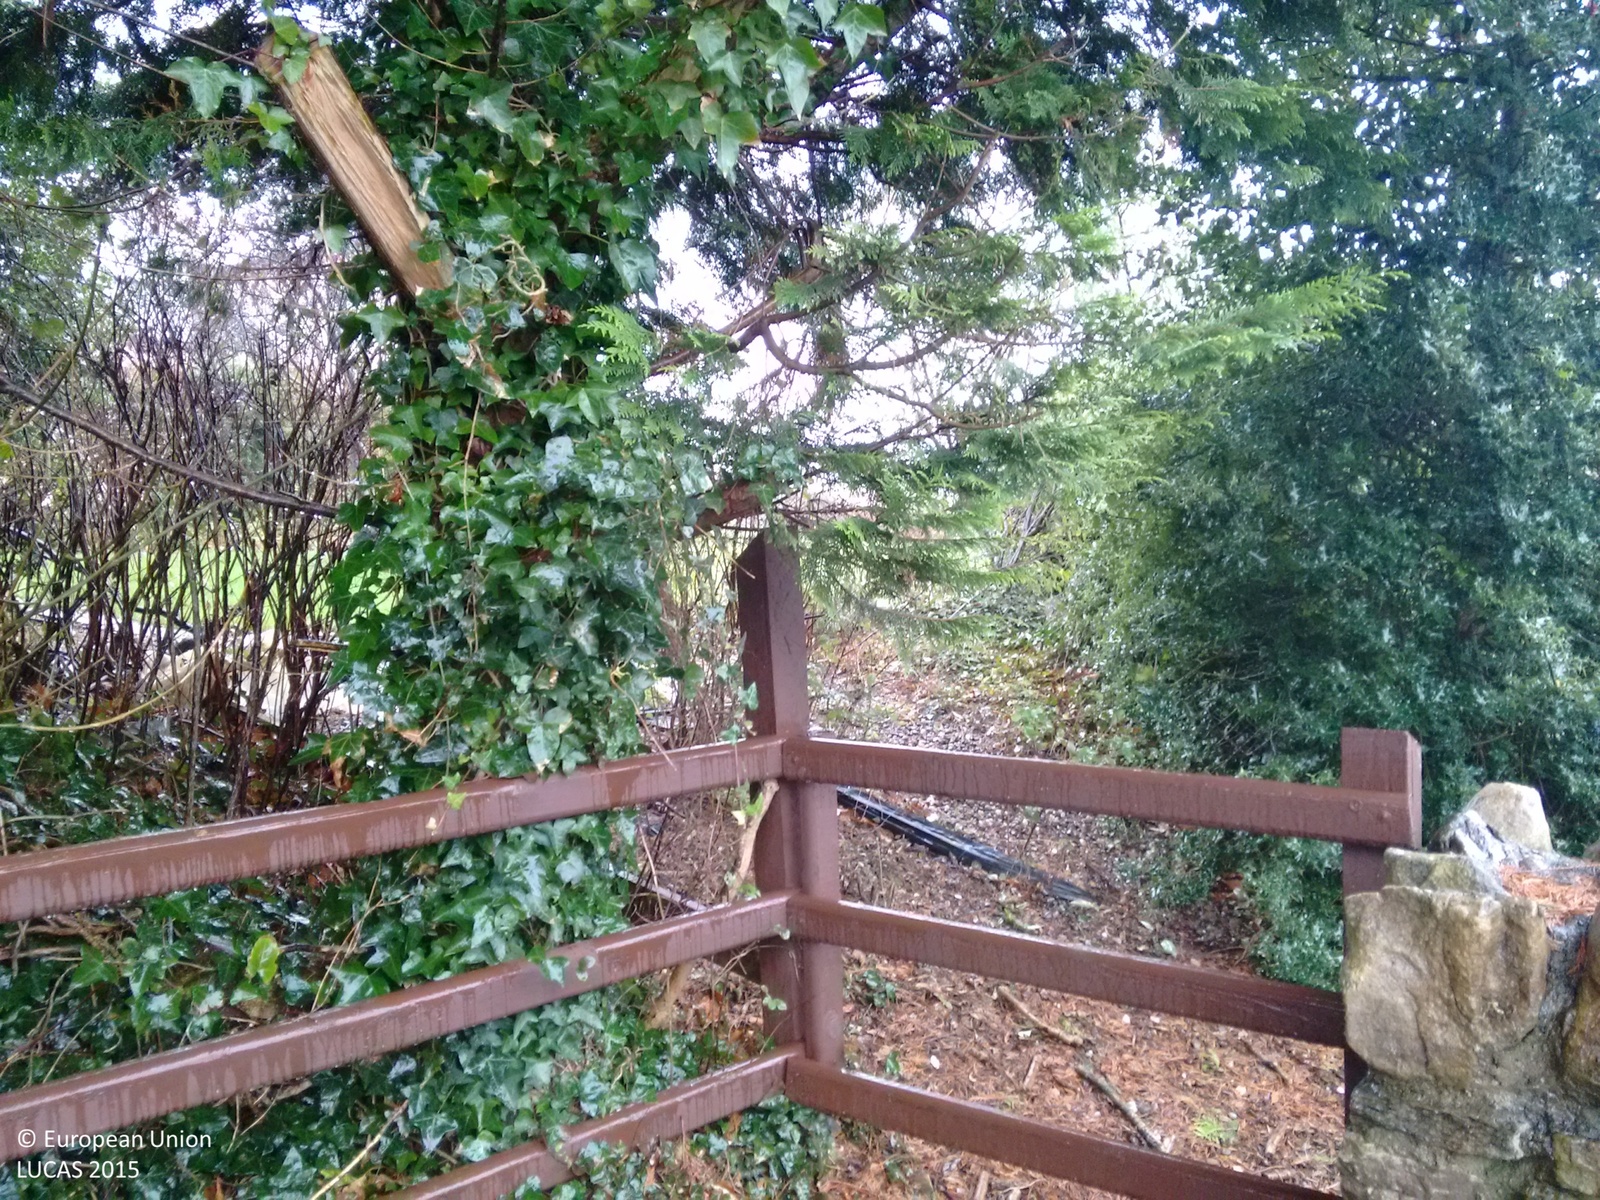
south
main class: Grassland
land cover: Grassland without tree/shrub cover
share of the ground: > 75 %
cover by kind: herbaceous plants 100 %
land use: Residential
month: November
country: IE
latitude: 54.5251
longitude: -8.1475
